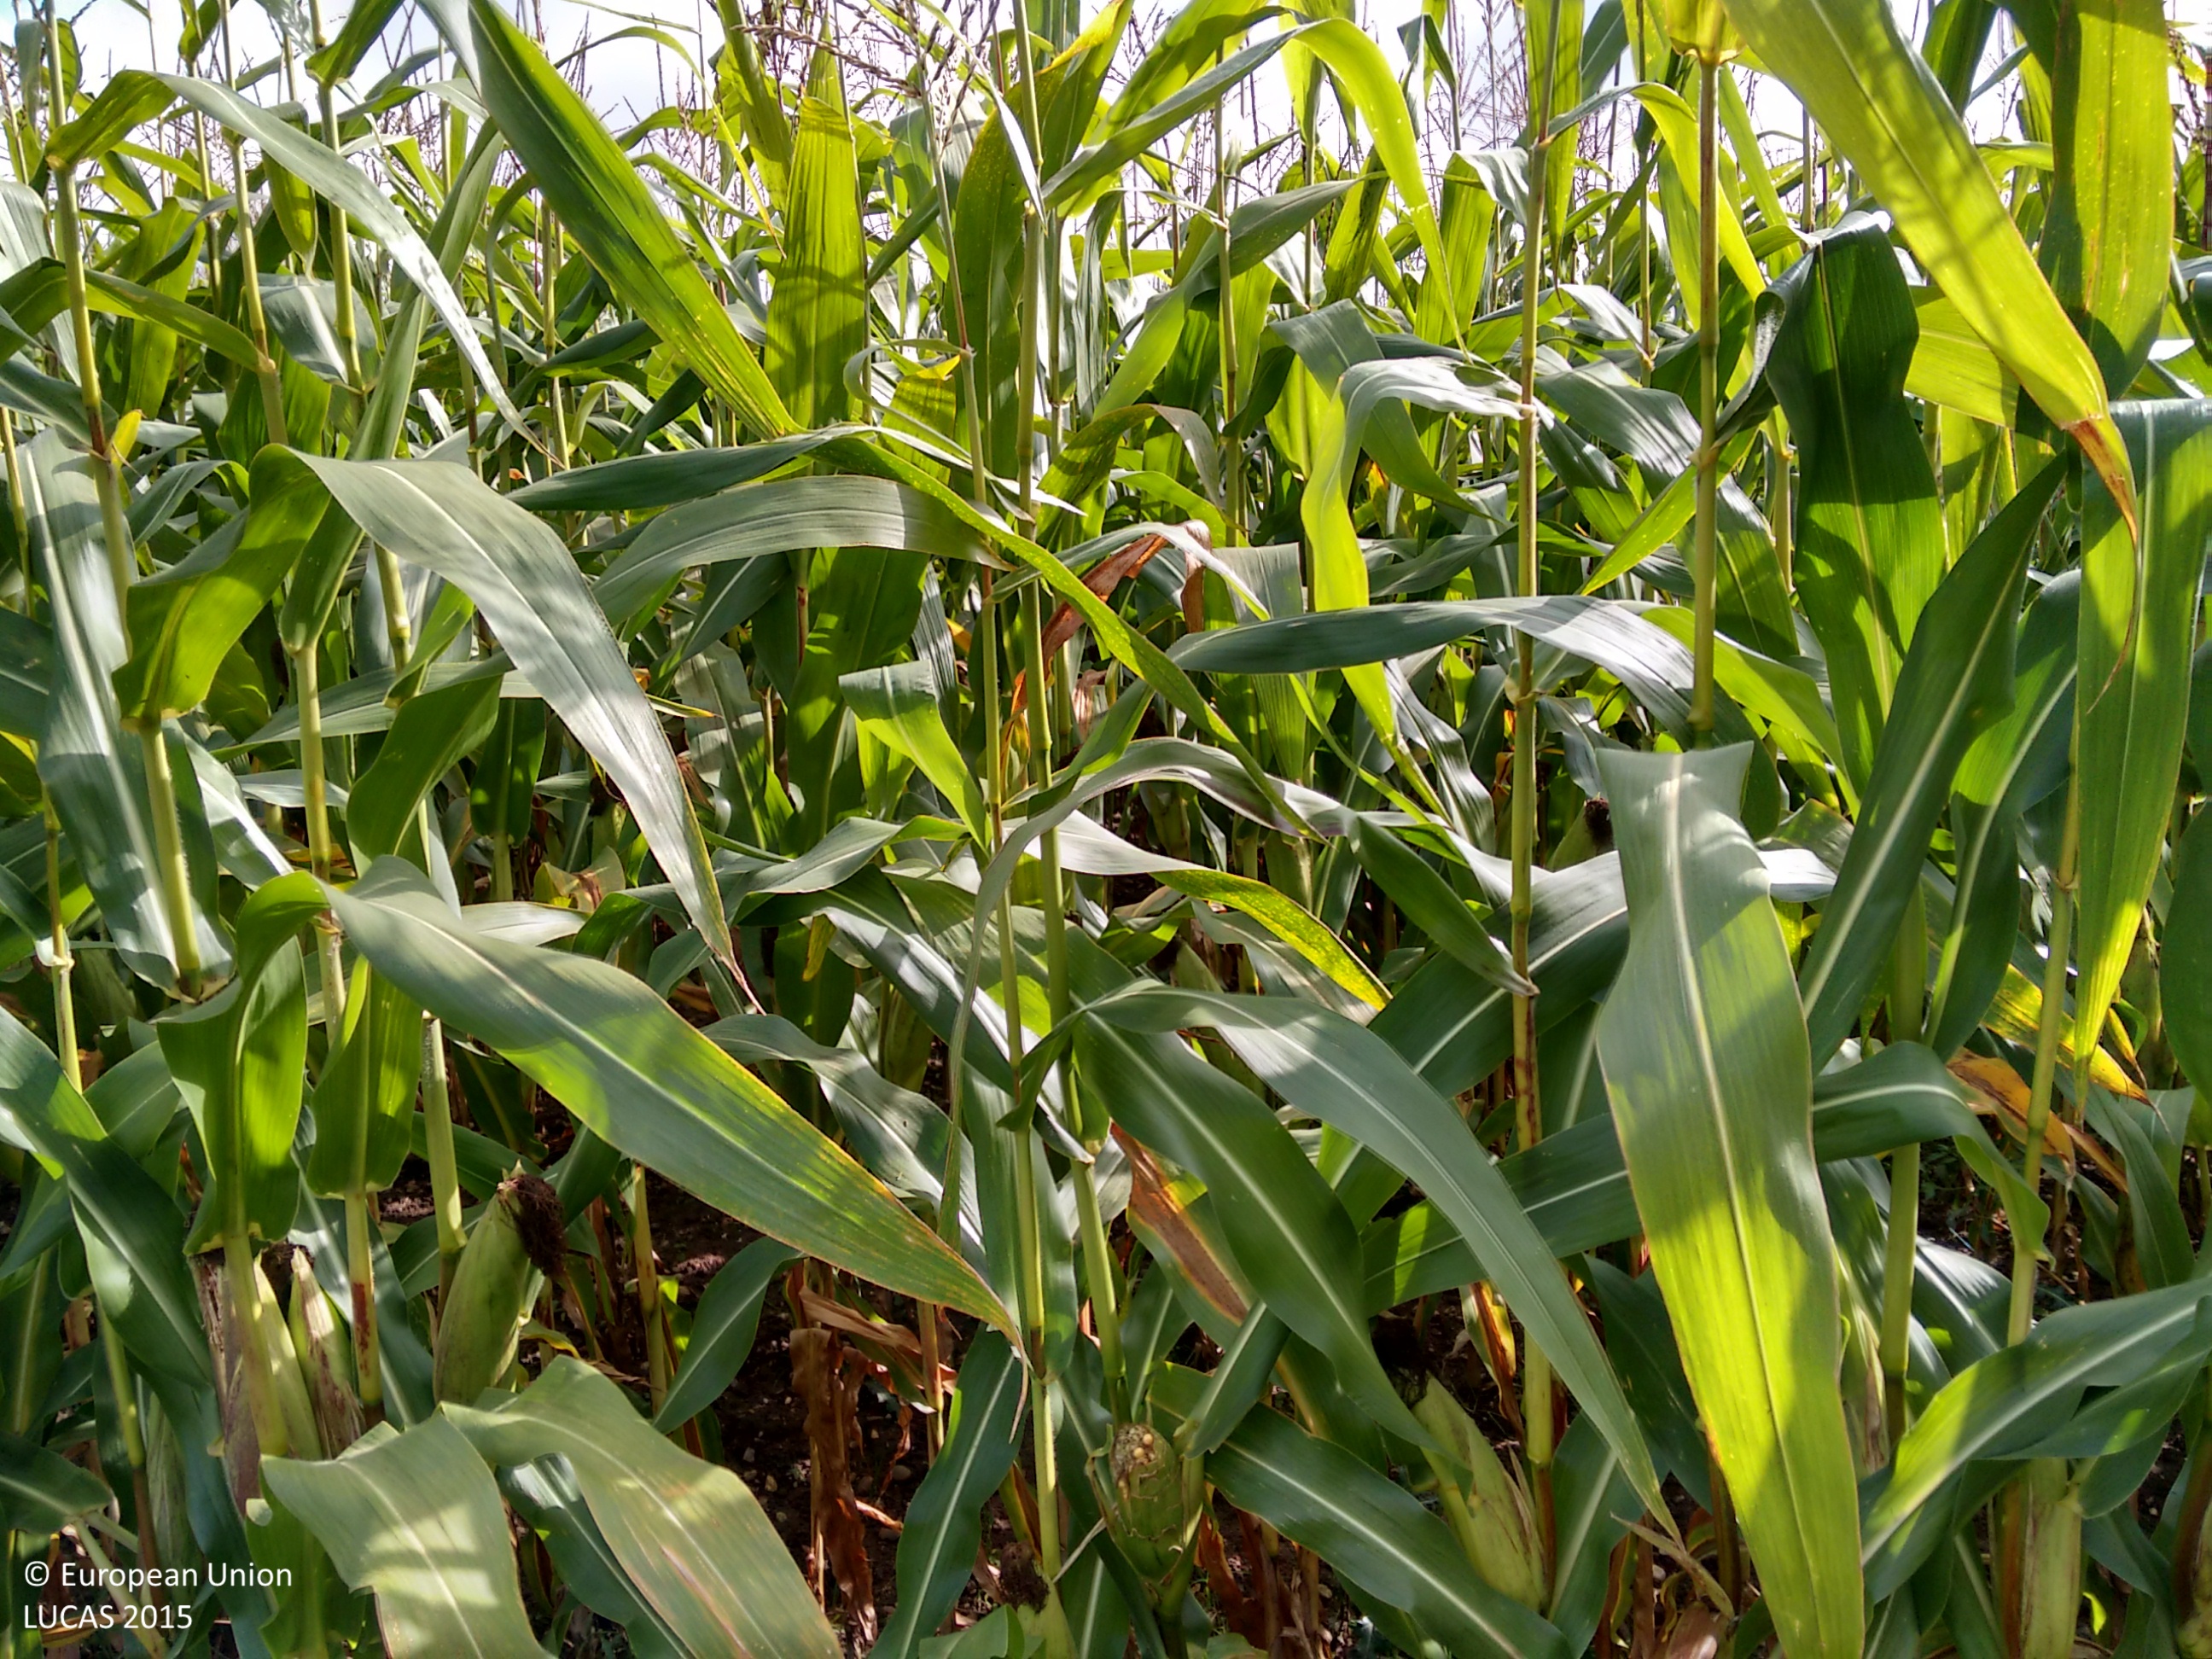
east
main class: Woodland
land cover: Broadleaved woodland
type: mesophytic deciduous forest
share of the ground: > 75 %
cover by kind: broadleaved forest trees 100 %
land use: Forestry
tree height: > 5 m
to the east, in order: Broadleaved woodland; Grass margins; Fences; Grass margins; Maize; Grass margins; Electric lines; Abandoned hedges; Grassland with sparse tree/shrub cover; Artificial constructions in urban areas
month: September
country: GB
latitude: 52.5404
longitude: 1.4733
